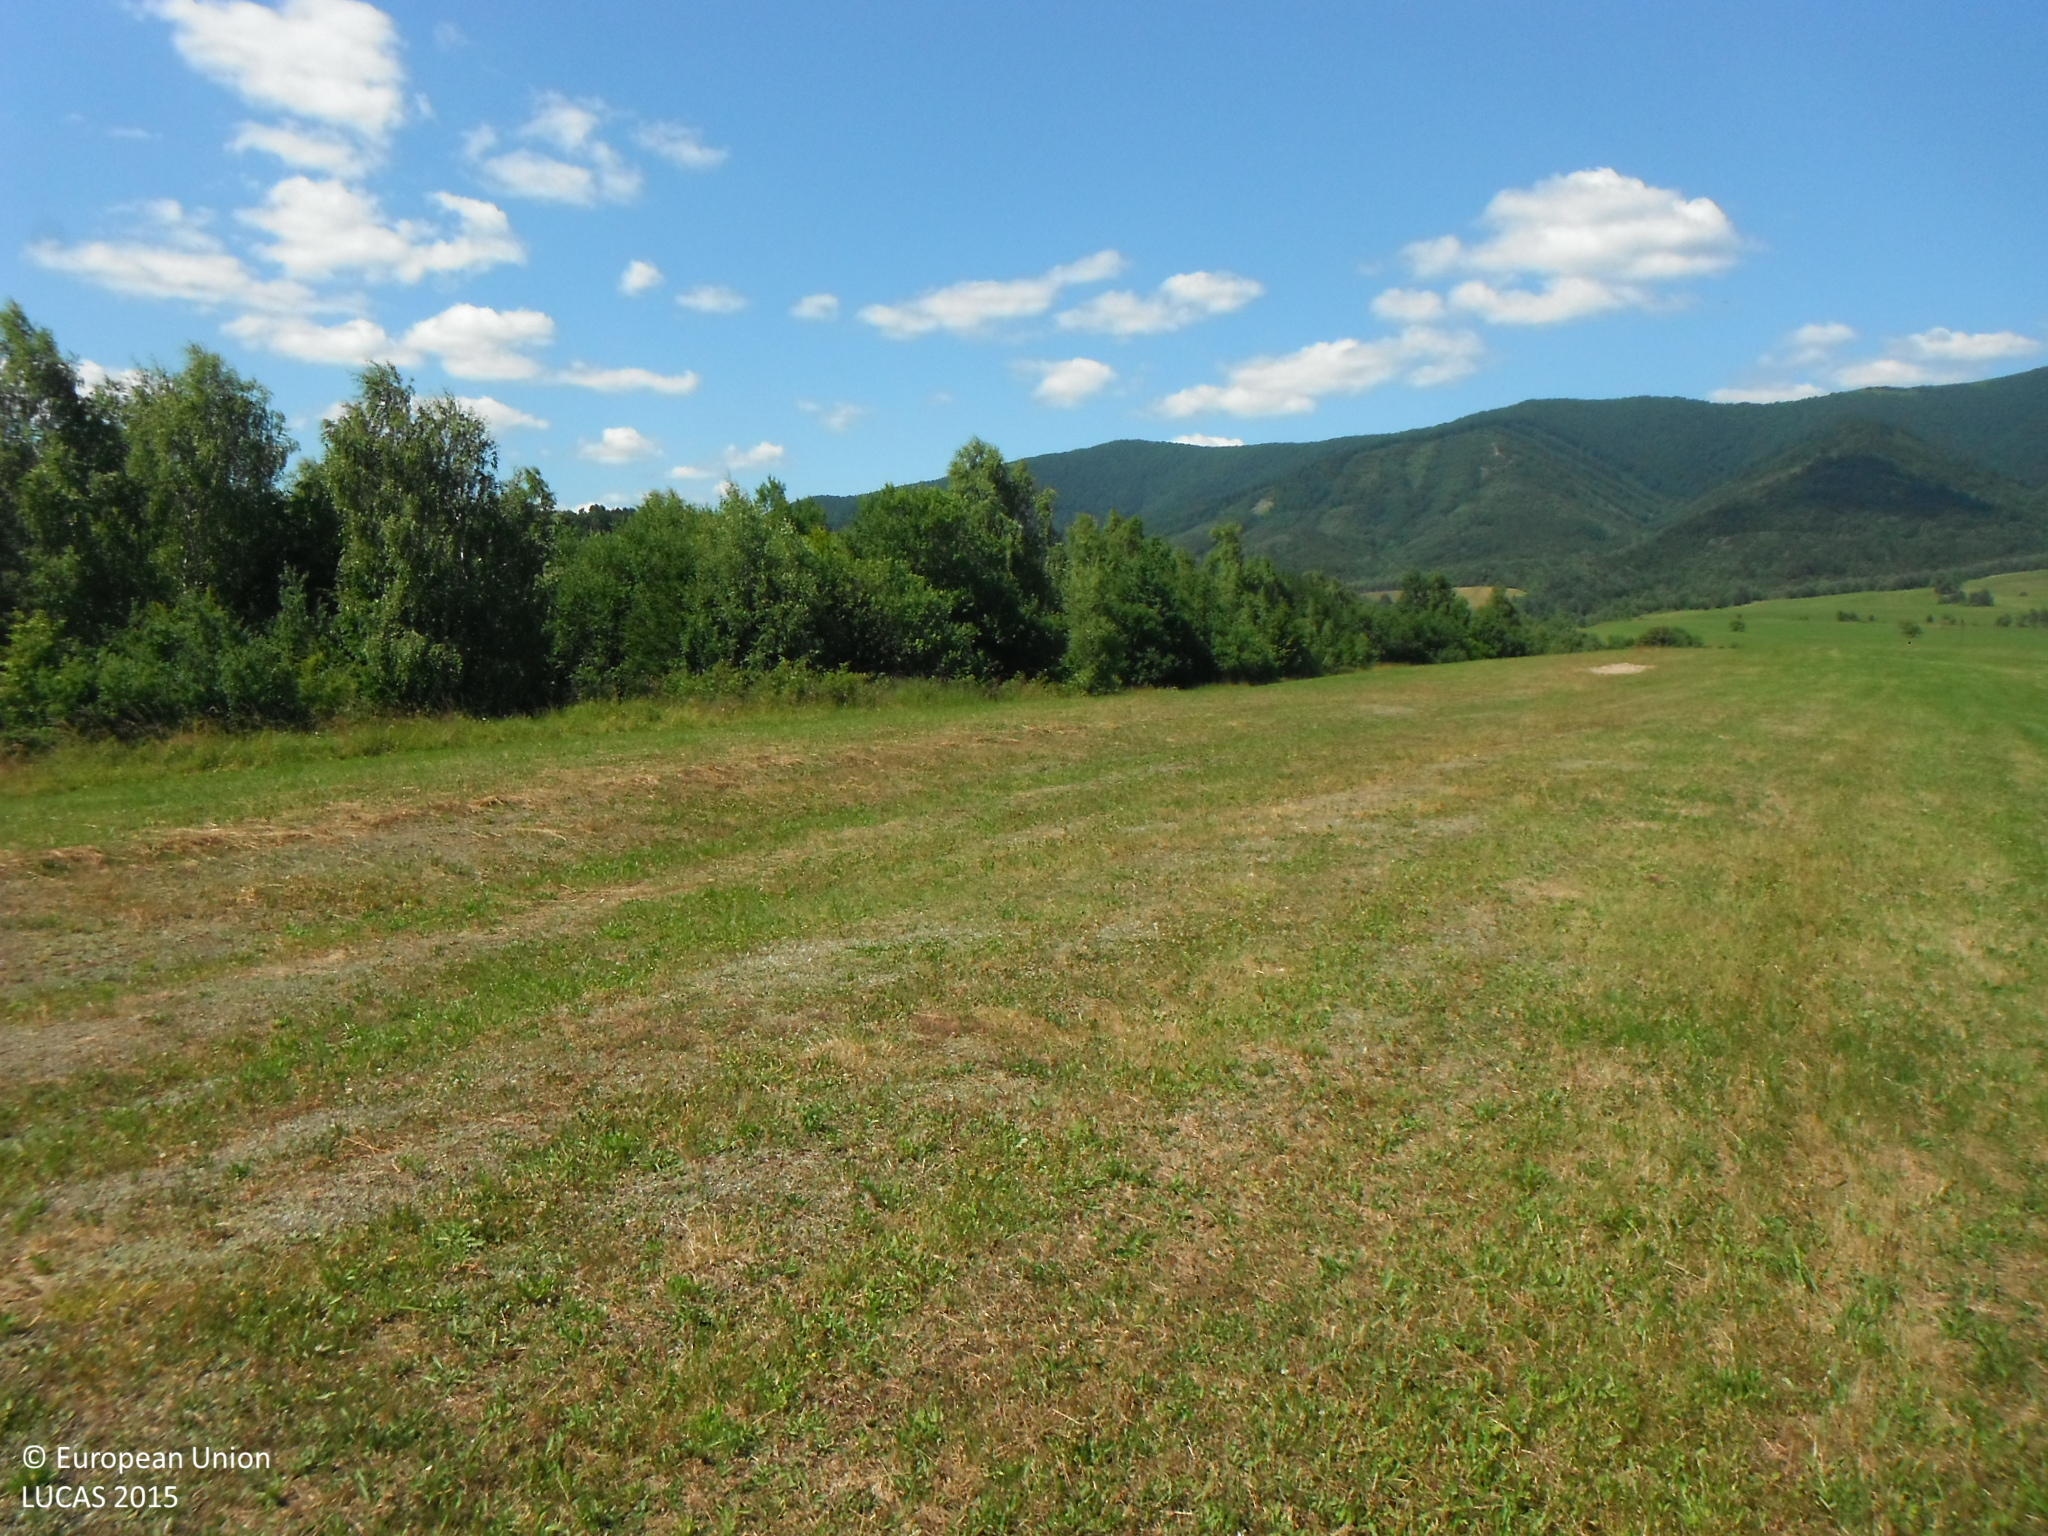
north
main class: Grassland
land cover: Grassland without tree/shrub cover
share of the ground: > 75 %
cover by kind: herbaceous plants 100 %
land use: Agriculture (excluding fallow land and kitchen gardens)
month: July
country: SK
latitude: 49.0680
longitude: 22.3942
